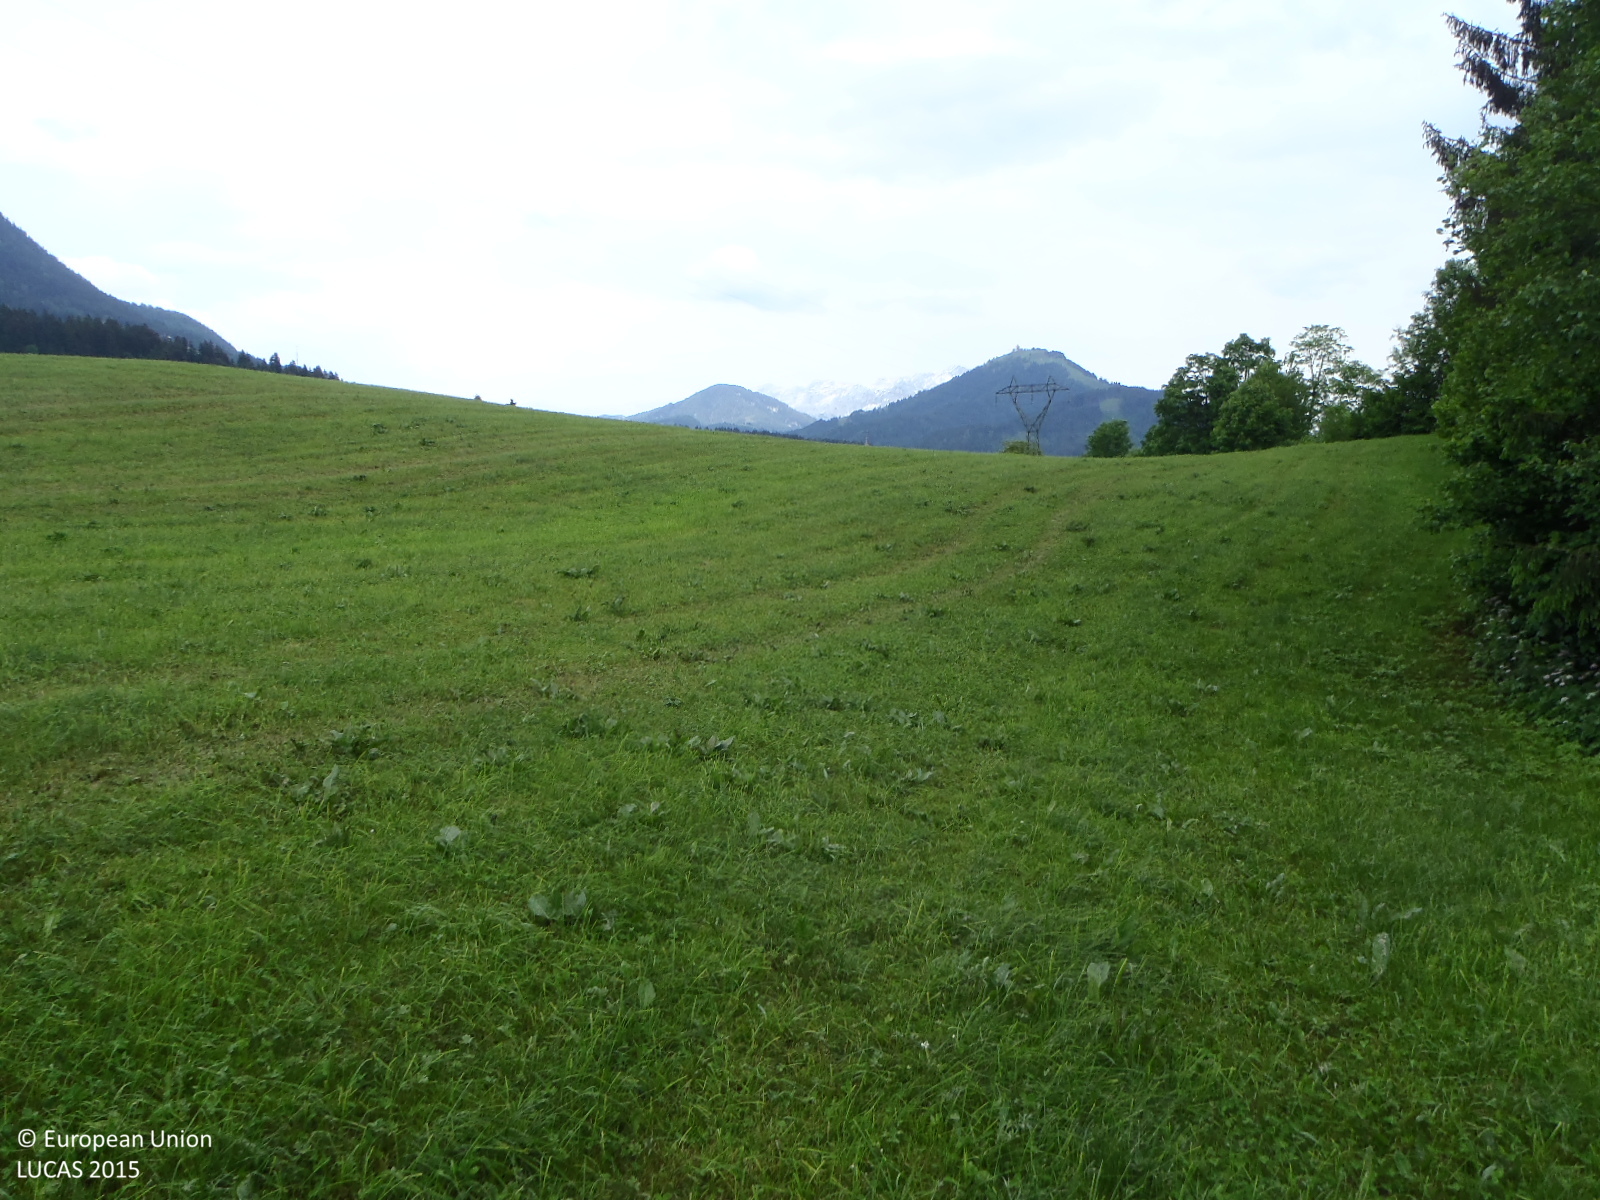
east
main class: Grassland
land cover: Grassland without tree/shrub cover
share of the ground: > 75 %
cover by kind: herbaceous plants 100 %
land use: Agriculture (excluding fallow land and kitchen gardens)
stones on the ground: < 10 %
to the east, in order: Grassland without tree/shrub cover; Electric lines; Grassland without tree/shrub cover; Artificial constructions in urban areas; Grassland with sparse tree/shrub cover
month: June
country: AT
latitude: 47.4928
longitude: 12.5070
